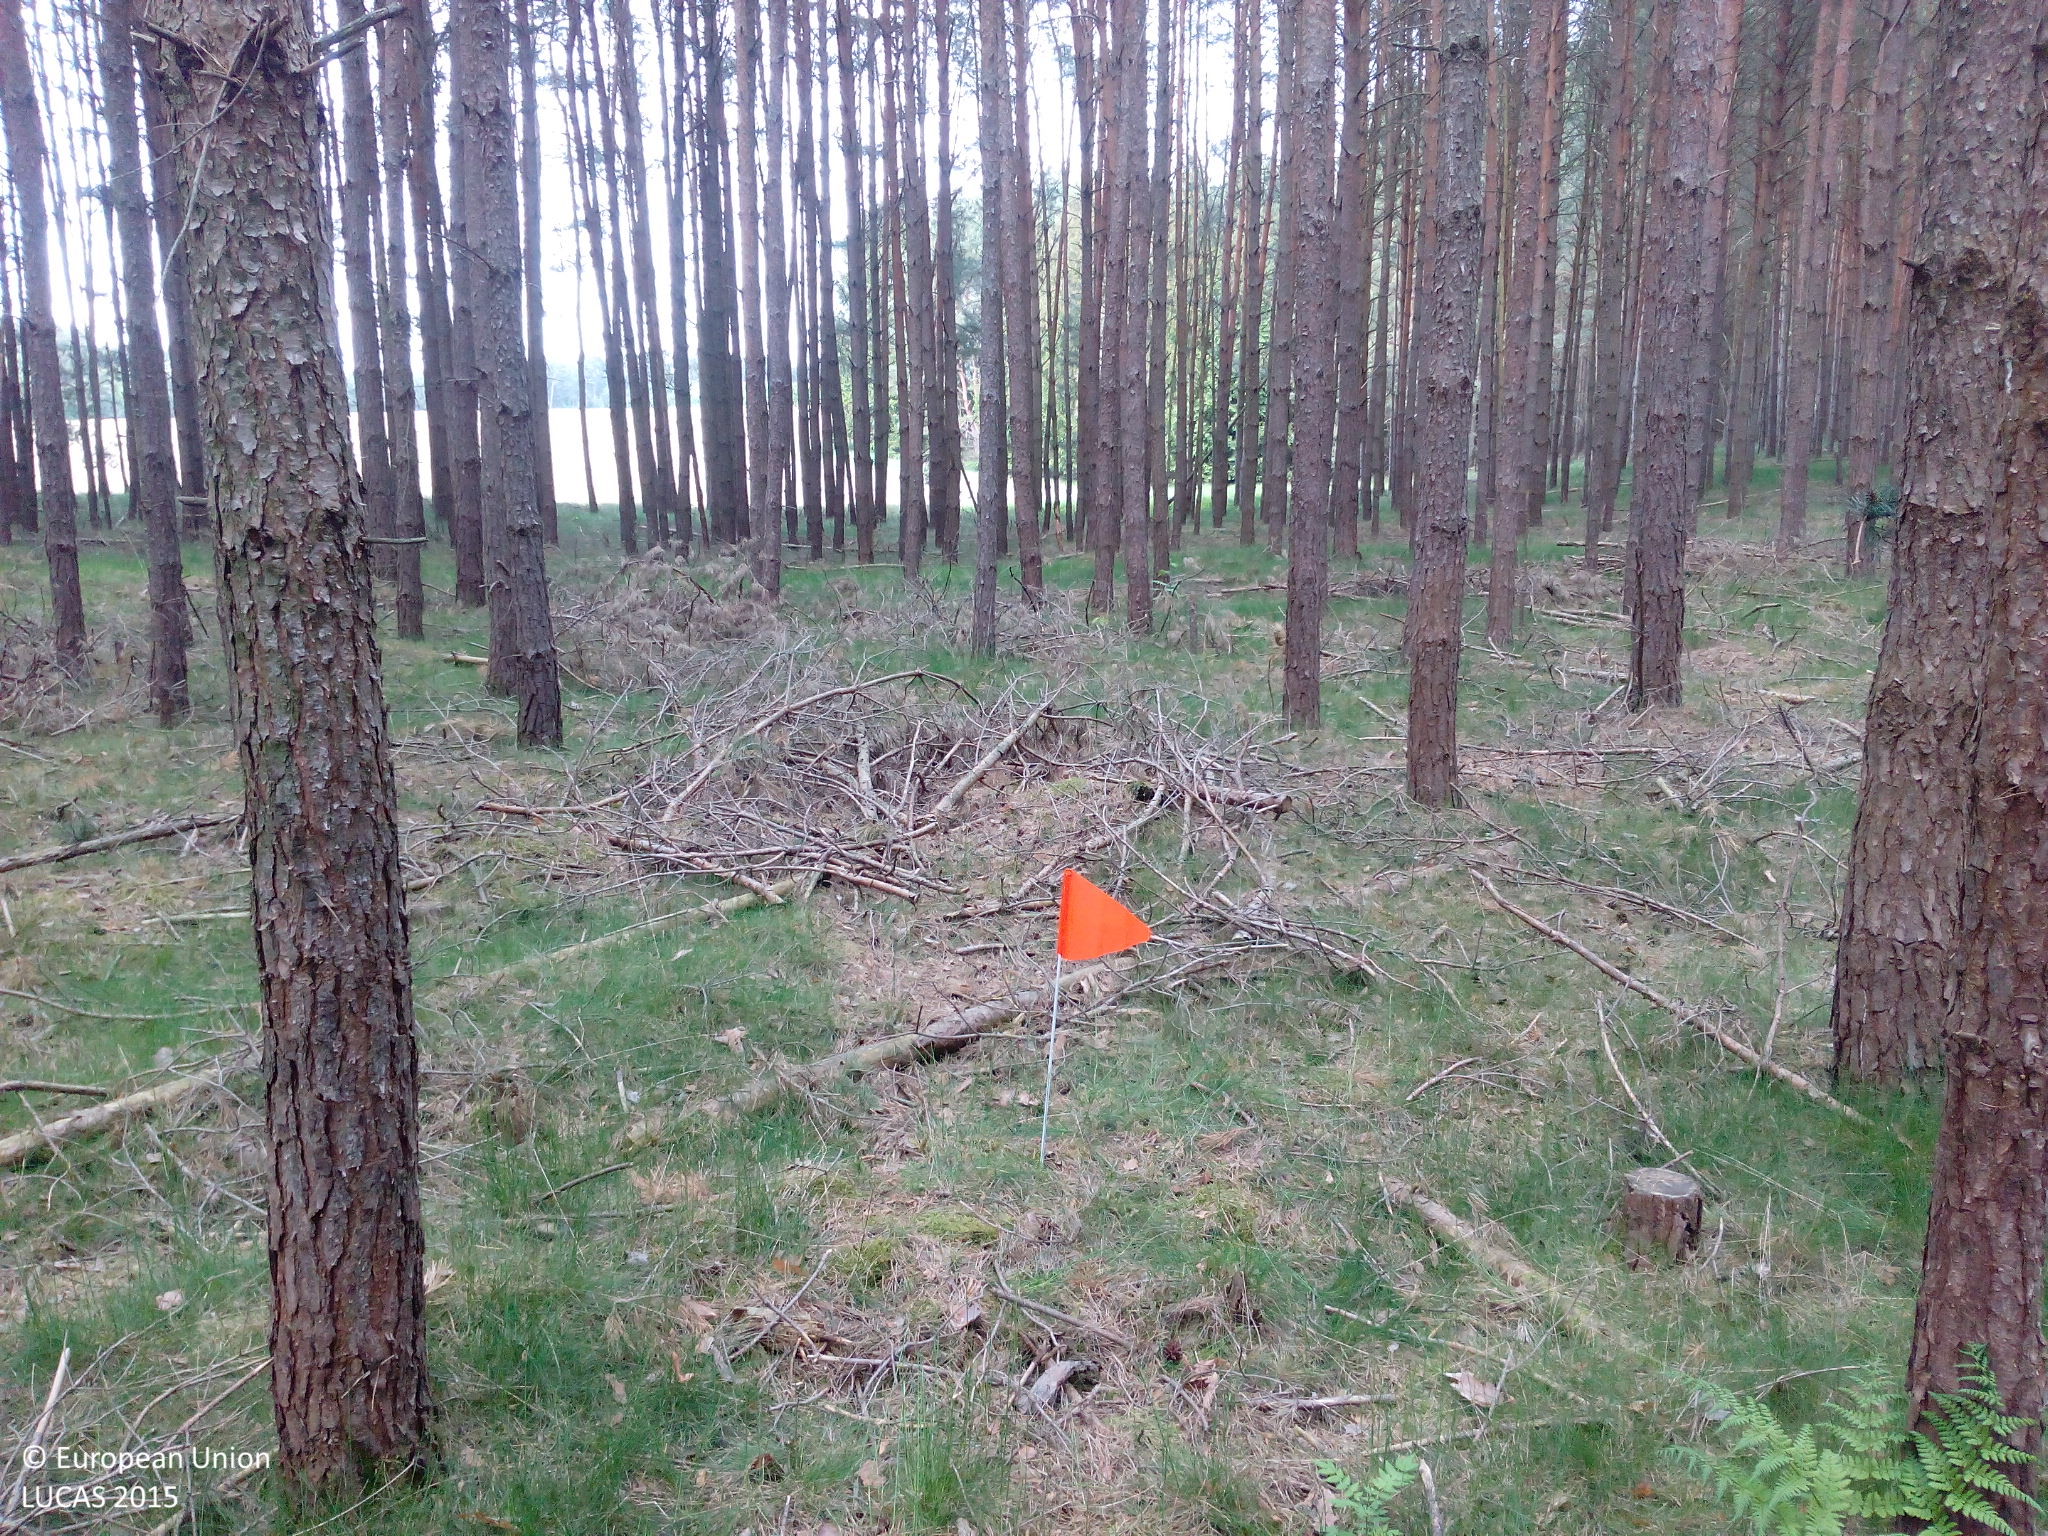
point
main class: Woodland
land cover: Pine dominated coniferous woodland
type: hemiboreal forest and nemoral coniferous forest and mixed broadleaved-coniferous forest
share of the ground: 50 - 75 %
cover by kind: coniferous forest trees 70 %, herbaceous plants 30 %
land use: Forestry
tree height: > 5 m
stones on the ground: < 10 %
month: May
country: DE
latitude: 52.6956
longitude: 11.1389
